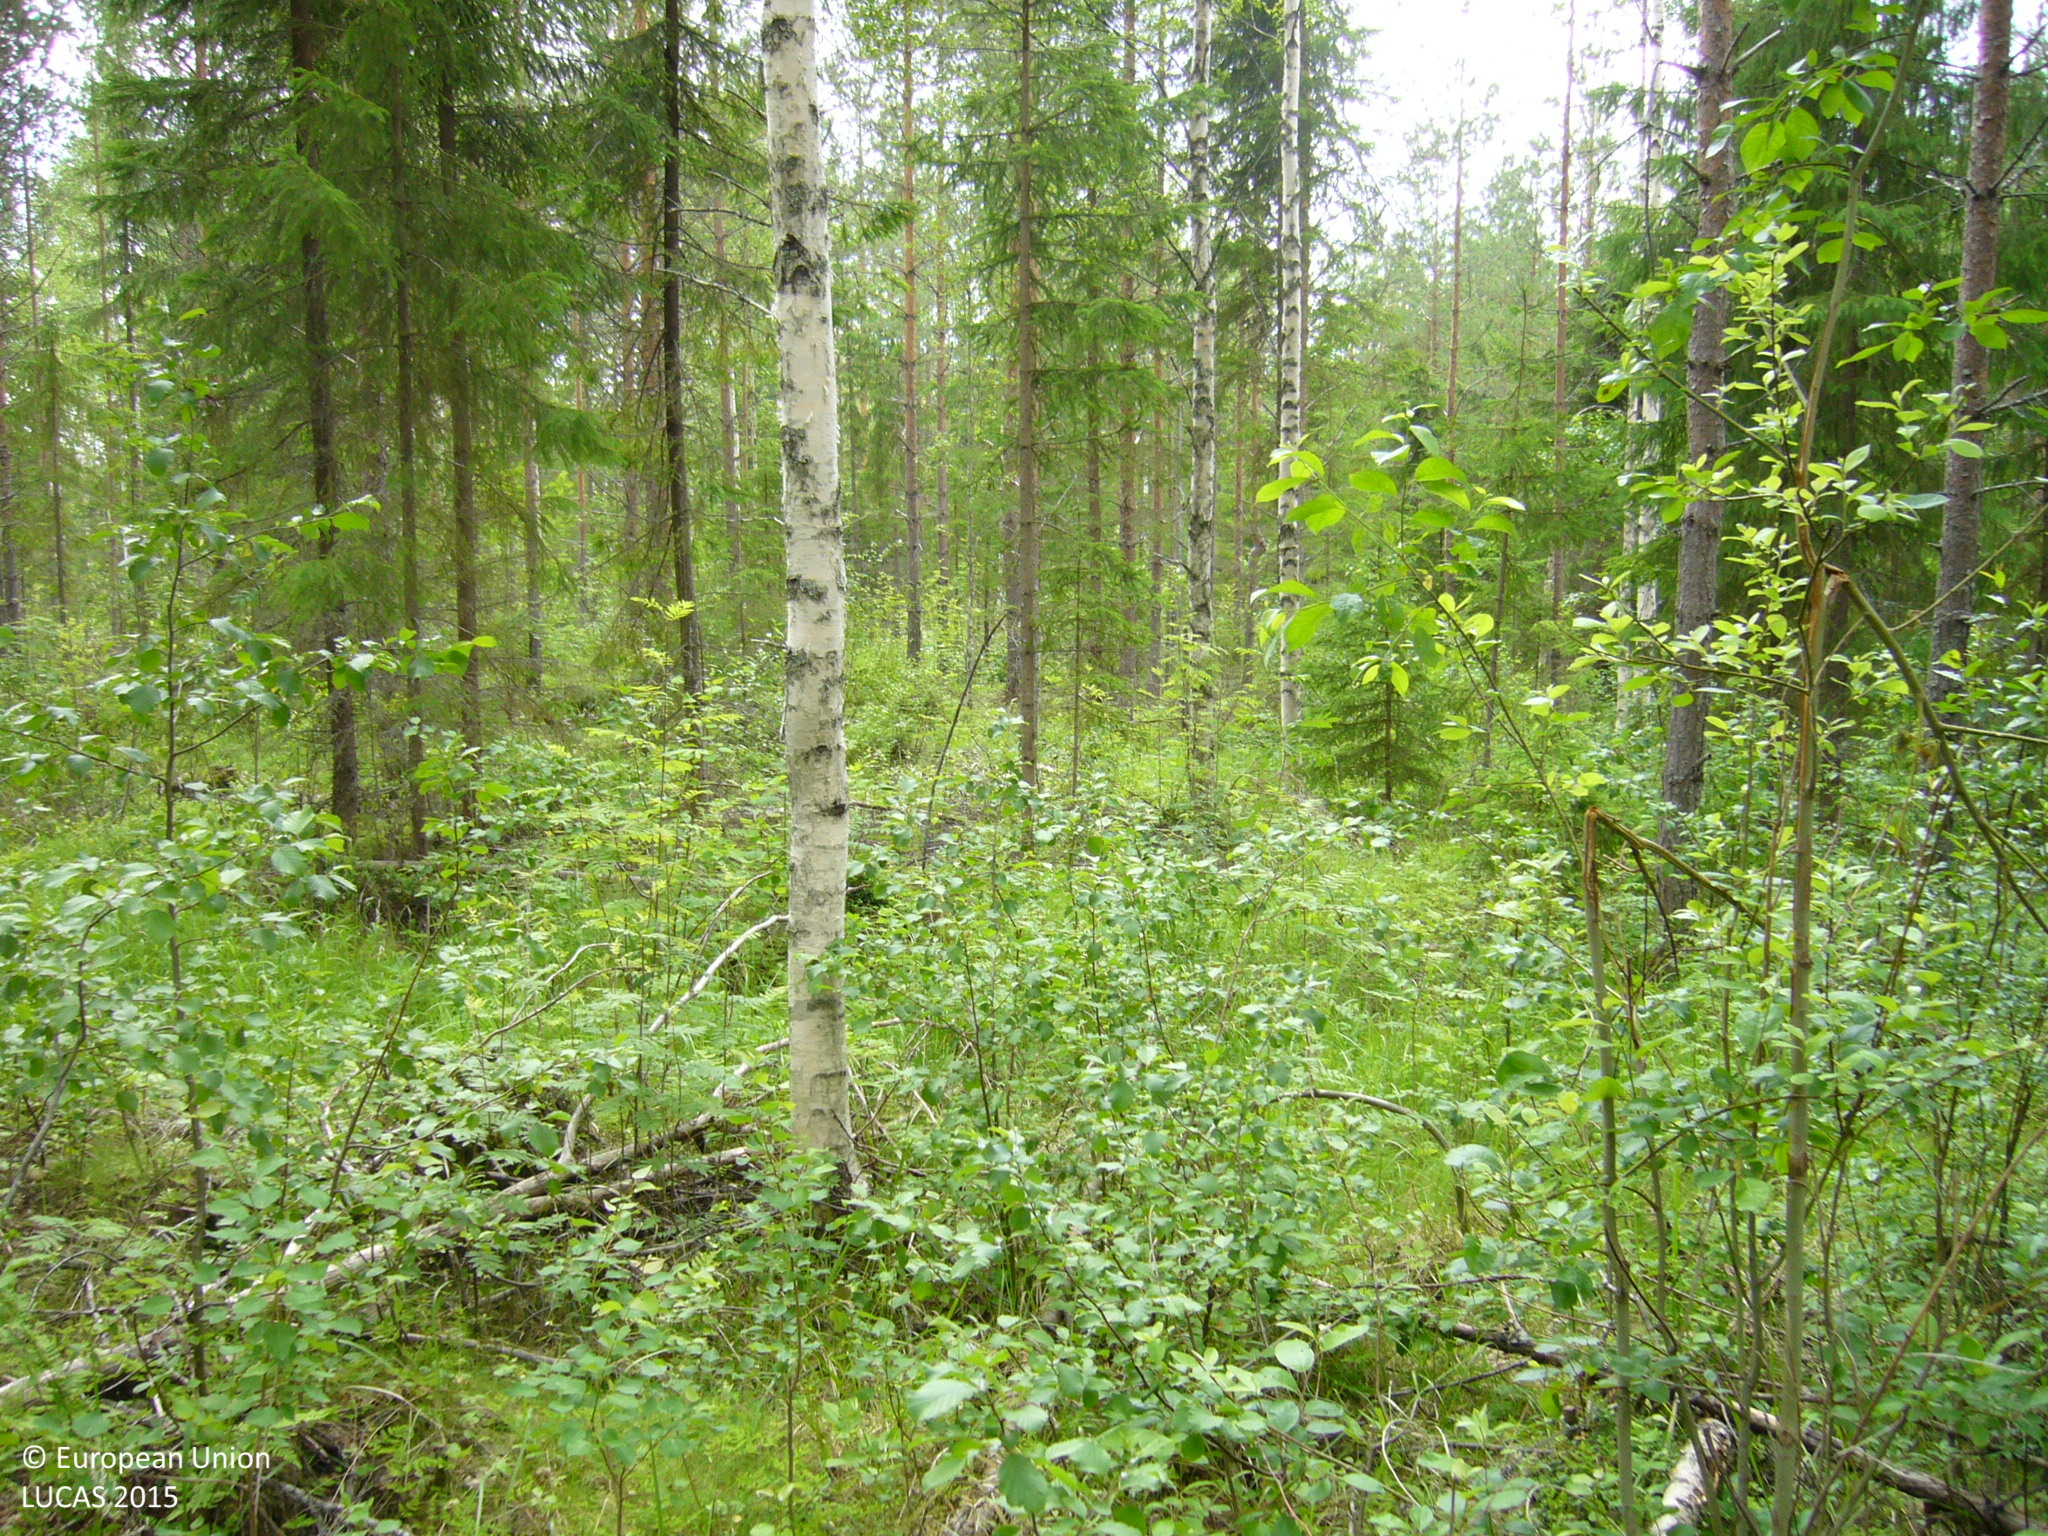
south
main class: Woodland
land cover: Pine dominated mixed woodland
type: boreal forest
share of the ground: > 75 %
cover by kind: coniferous forest trees 50 %, broadleaved forest trees 25 %, shrubs 25 %
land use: Forestry
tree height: > 5 m
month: July
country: FI
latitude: 63.1861
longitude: 26.0339
